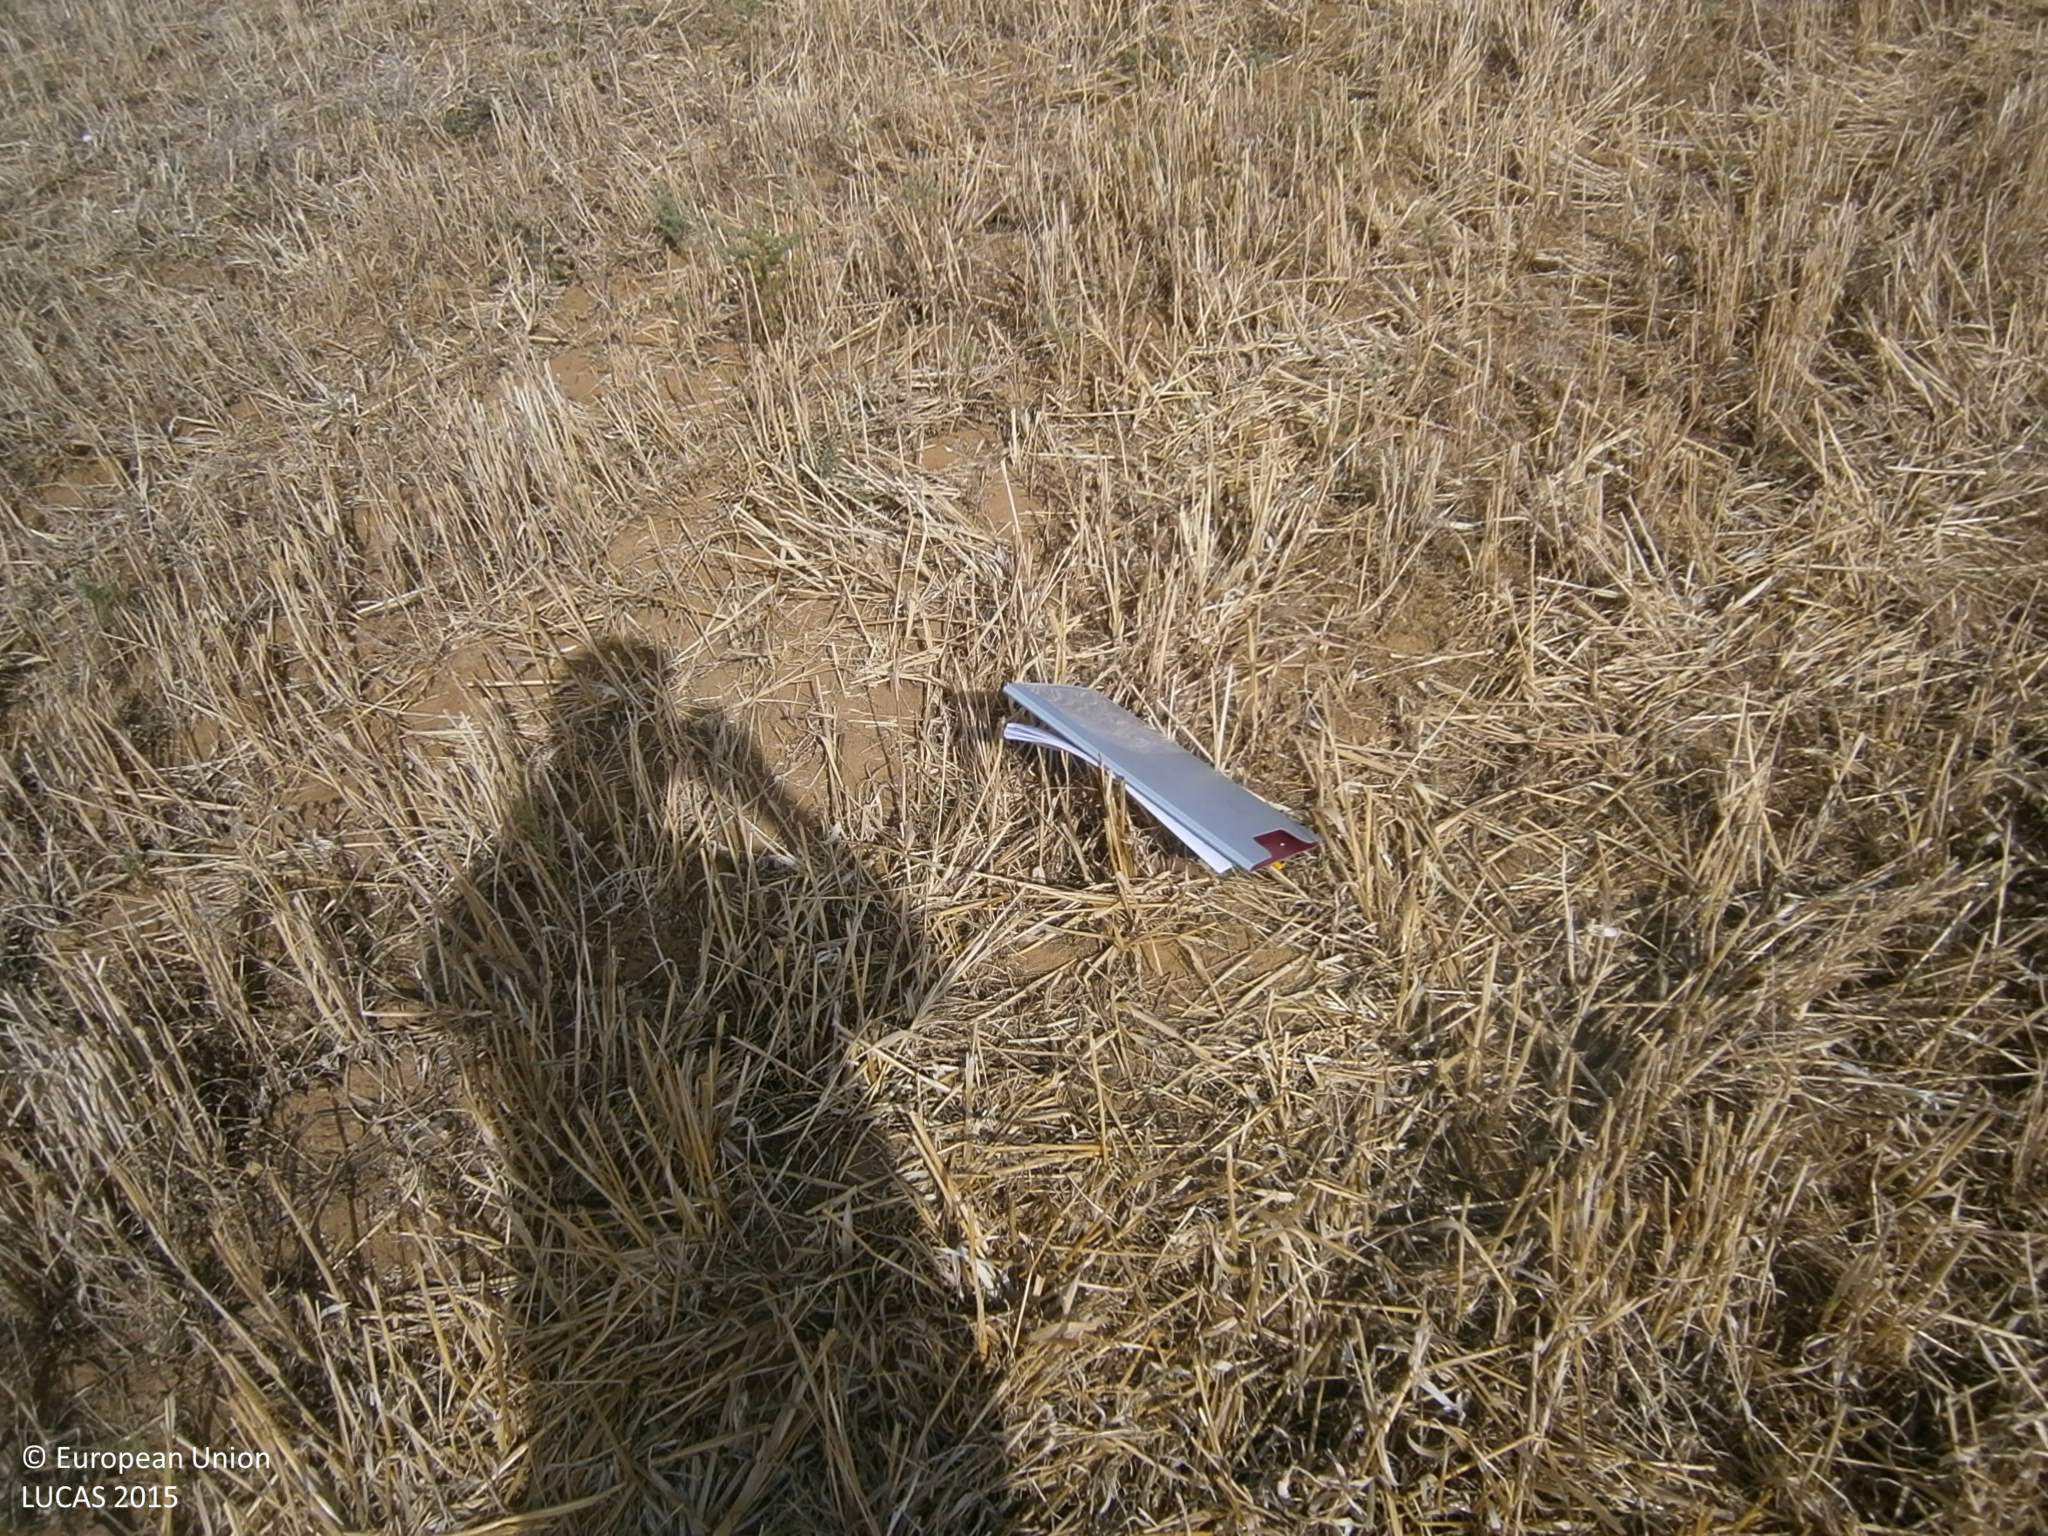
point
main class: Cropland
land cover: Temporary grasslands
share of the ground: > 75 %
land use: Agriculture (excluding fallow land and kitchen gardens)
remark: Harvested field
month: June
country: ES
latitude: 38.8483
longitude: -6.2431
